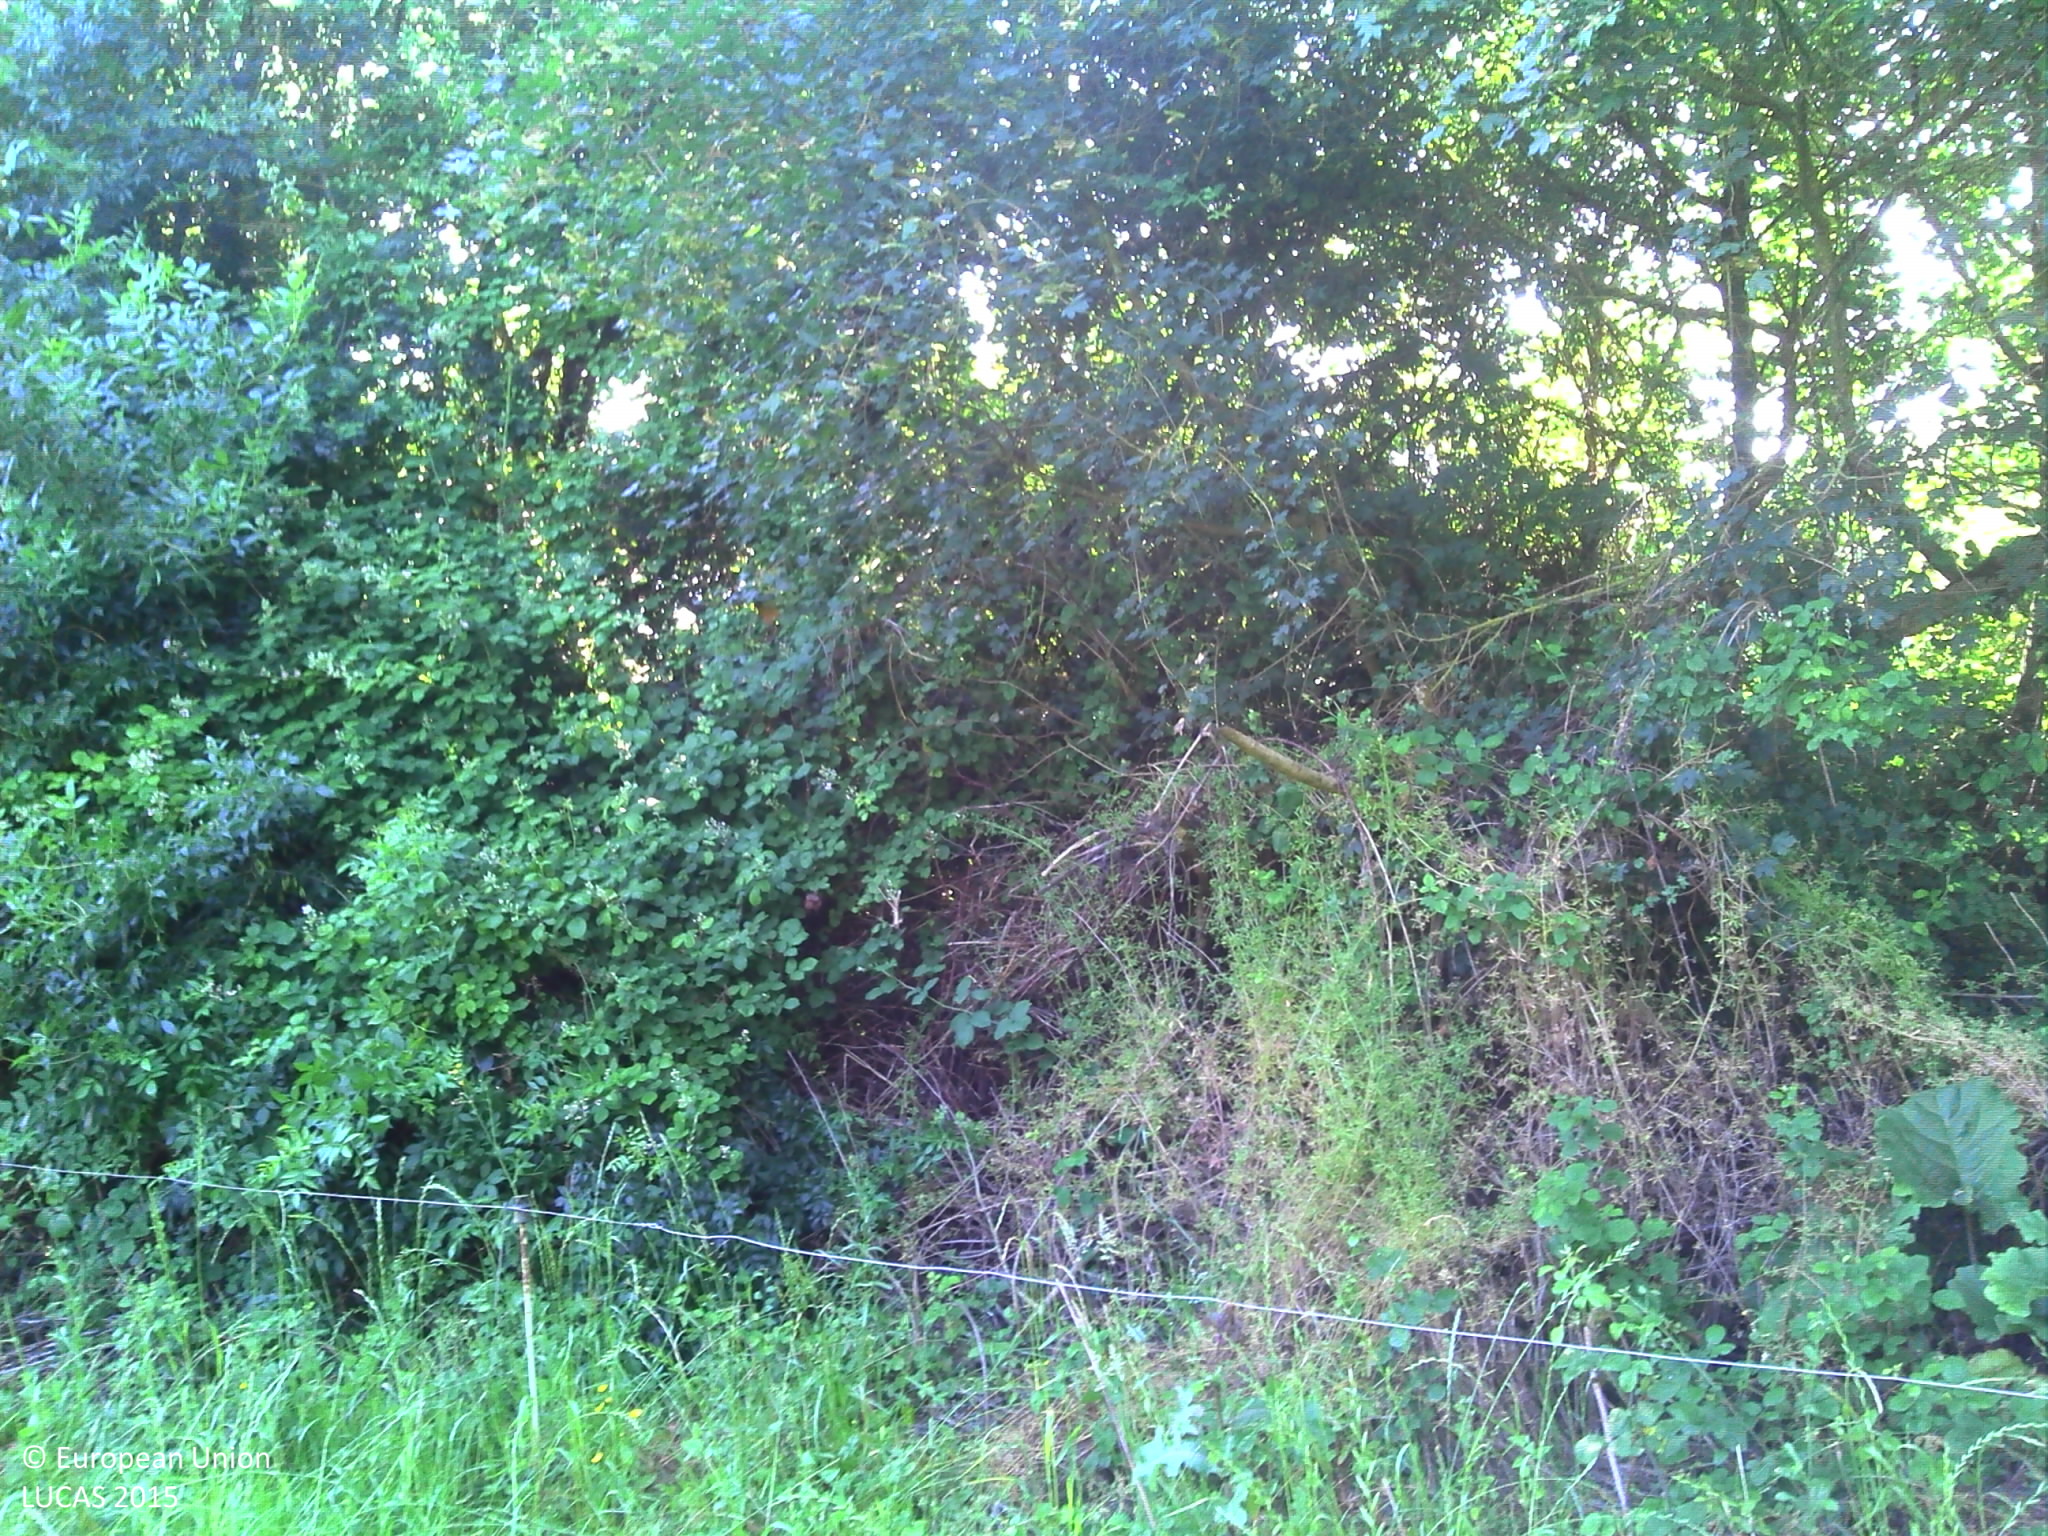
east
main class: Grassland
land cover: Grassland without tree/shrub cover
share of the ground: > 75 %
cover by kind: herbaceous plants 100 %
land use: Agriculture (excluding fallow land and kitchen gardens)
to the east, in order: Grassland without tree/shrub cover; Fences; Broadleaved woodland; Shrubland with sparse tree cover; Grassland without tree/shrub cover; Fences; Grassland without tree/shrub cover; Broadleaved woodland; Fences; Grassland without tree/shrub cover; Fences; Broadleaved woodland; Shrubland without tree cover; Grassland without tree/shrub cover; Broadleaved woodland; Shrubland without tree cover; Grassland without tree/shrub cover; Broadleaved woodland
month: June
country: FR
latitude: 46.9710
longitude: -1.7815
